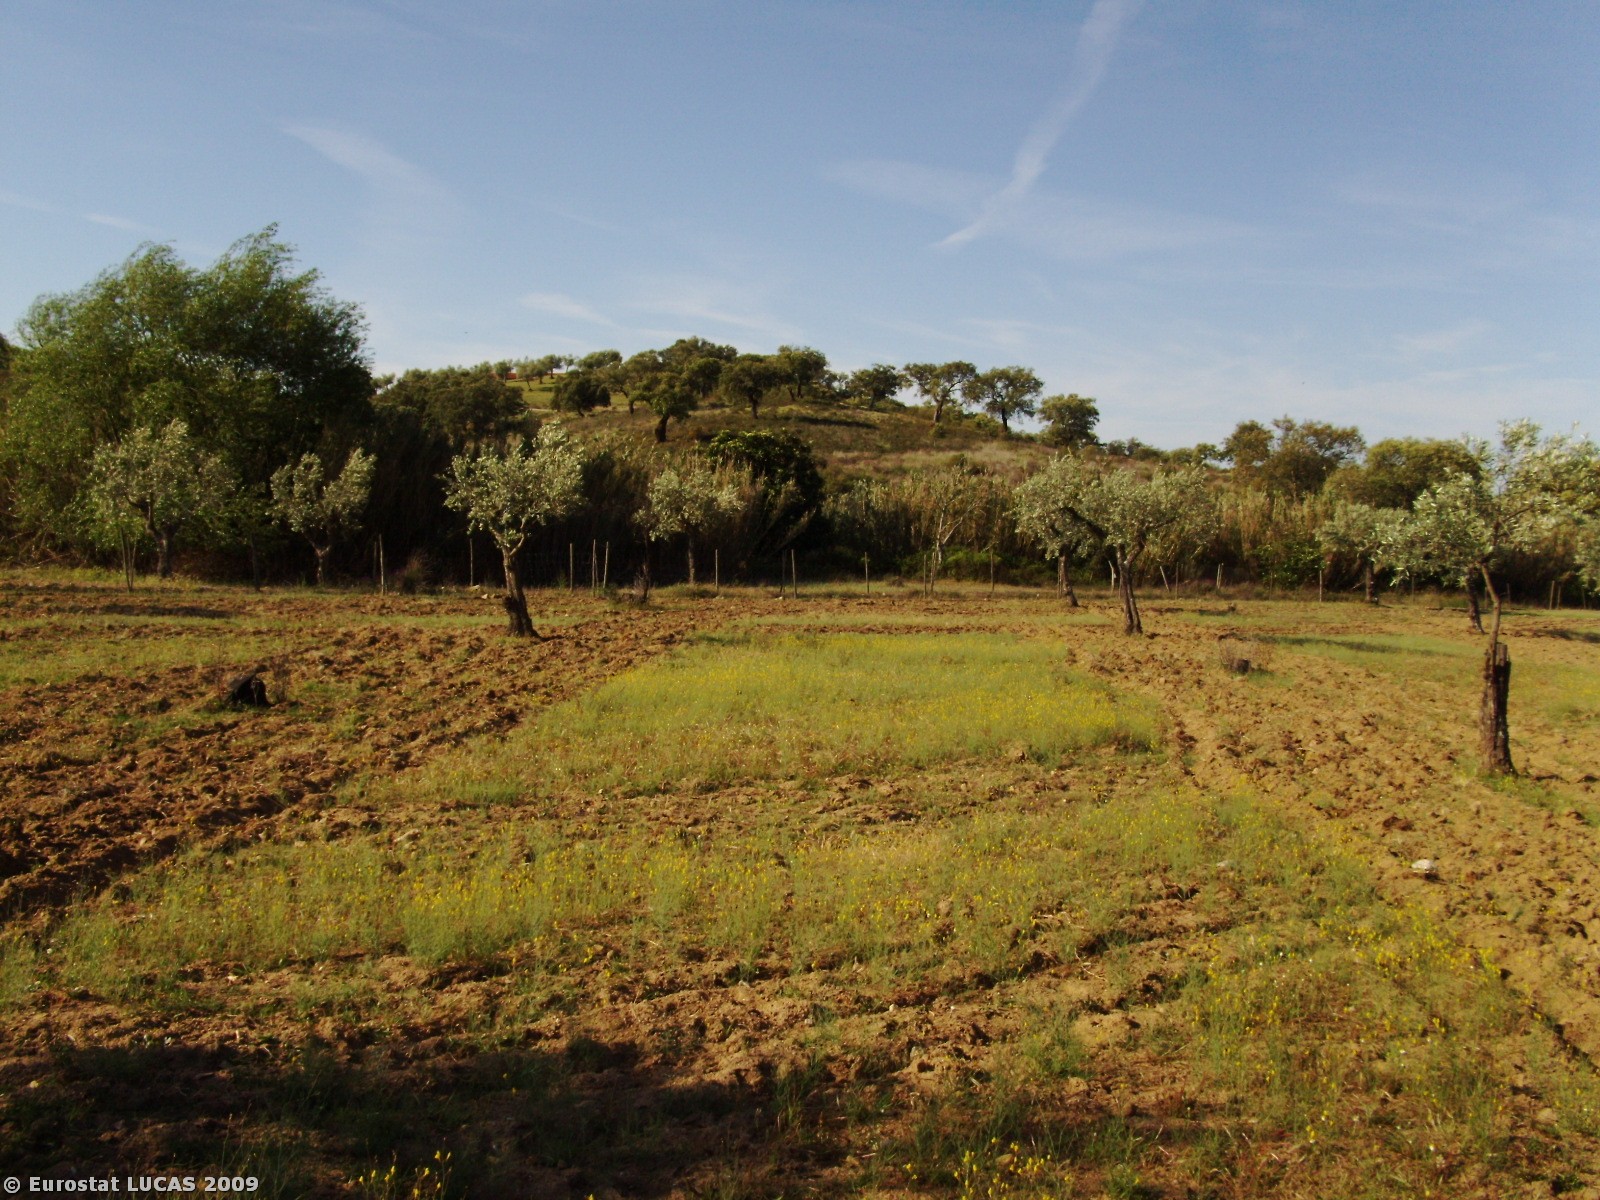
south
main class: Cropland
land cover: Olive groves
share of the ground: 10 - 25 %
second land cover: Spontaneously vegetated surfaces
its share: > 75 %
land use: Agriculture (excluding fallow land and kitchen gardens)
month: May
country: PT
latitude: 39.6996
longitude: -7.5808
